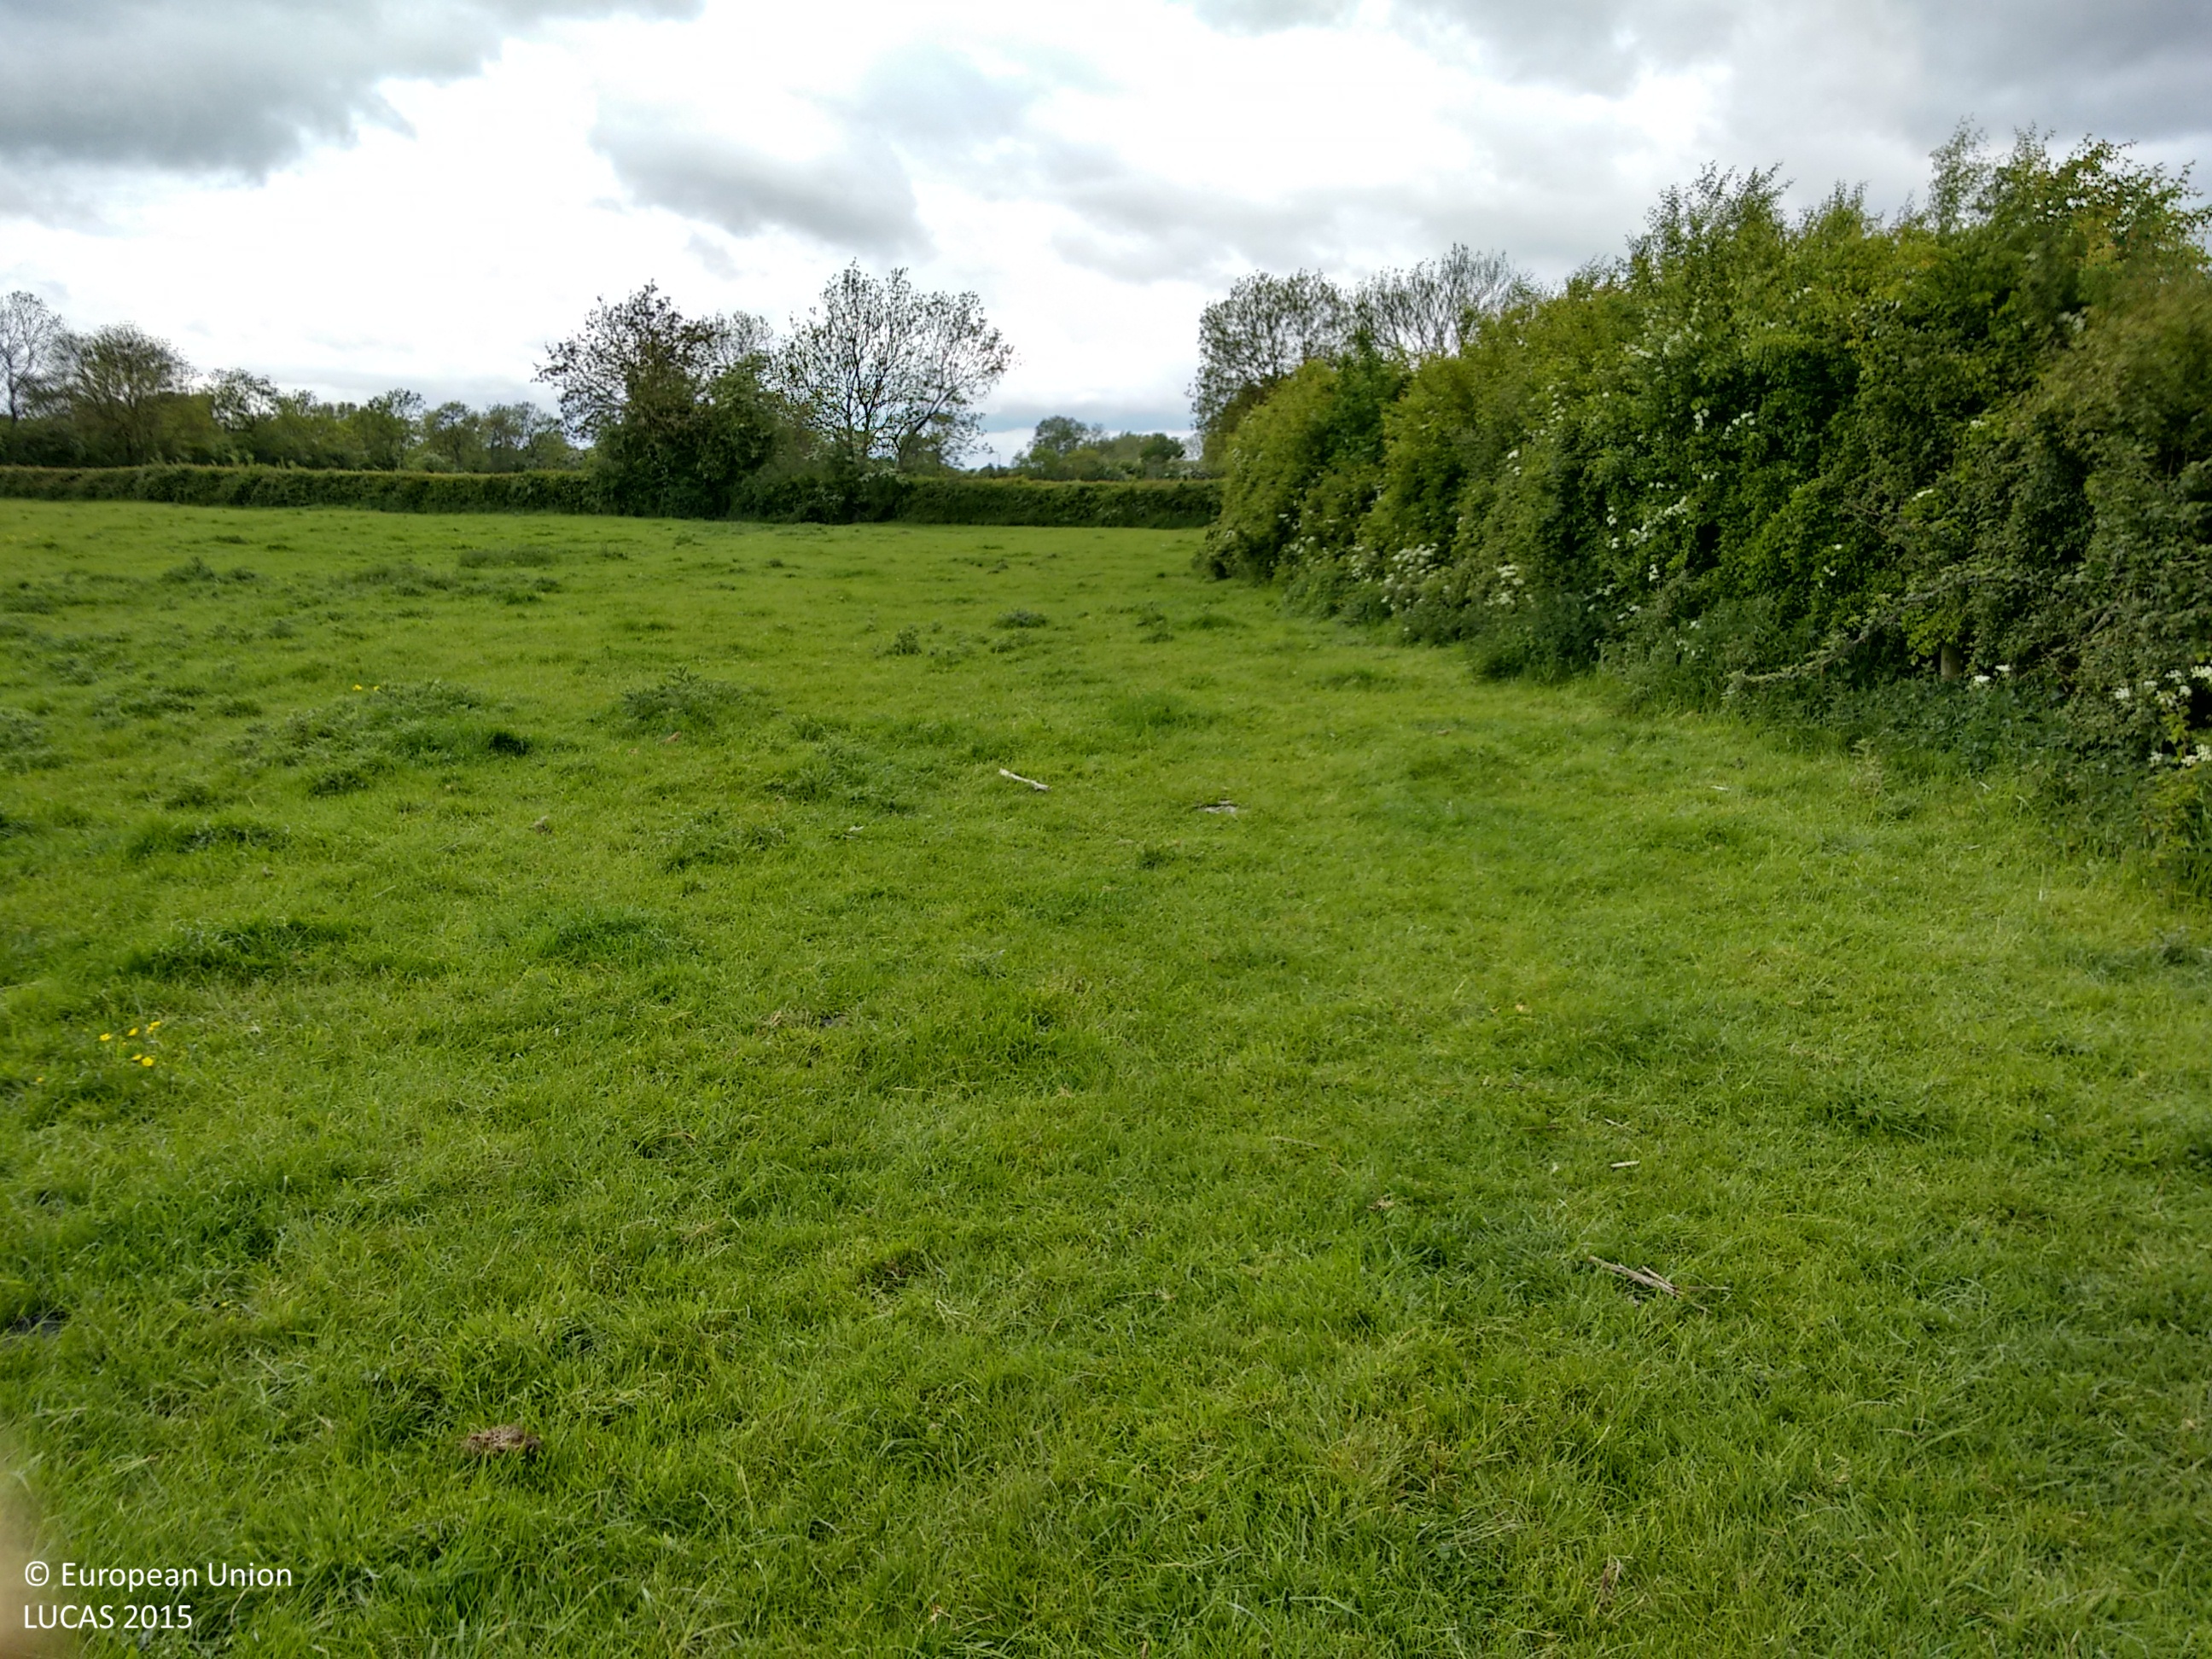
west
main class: Grassland
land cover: Grassland without tree/shrub cover
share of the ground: > 75 %
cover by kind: herbaceous plants 100 %
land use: Agriculture (excluding fallow land and kitchen gardens)
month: May
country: GB
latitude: 53.6016
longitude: -1.0604
